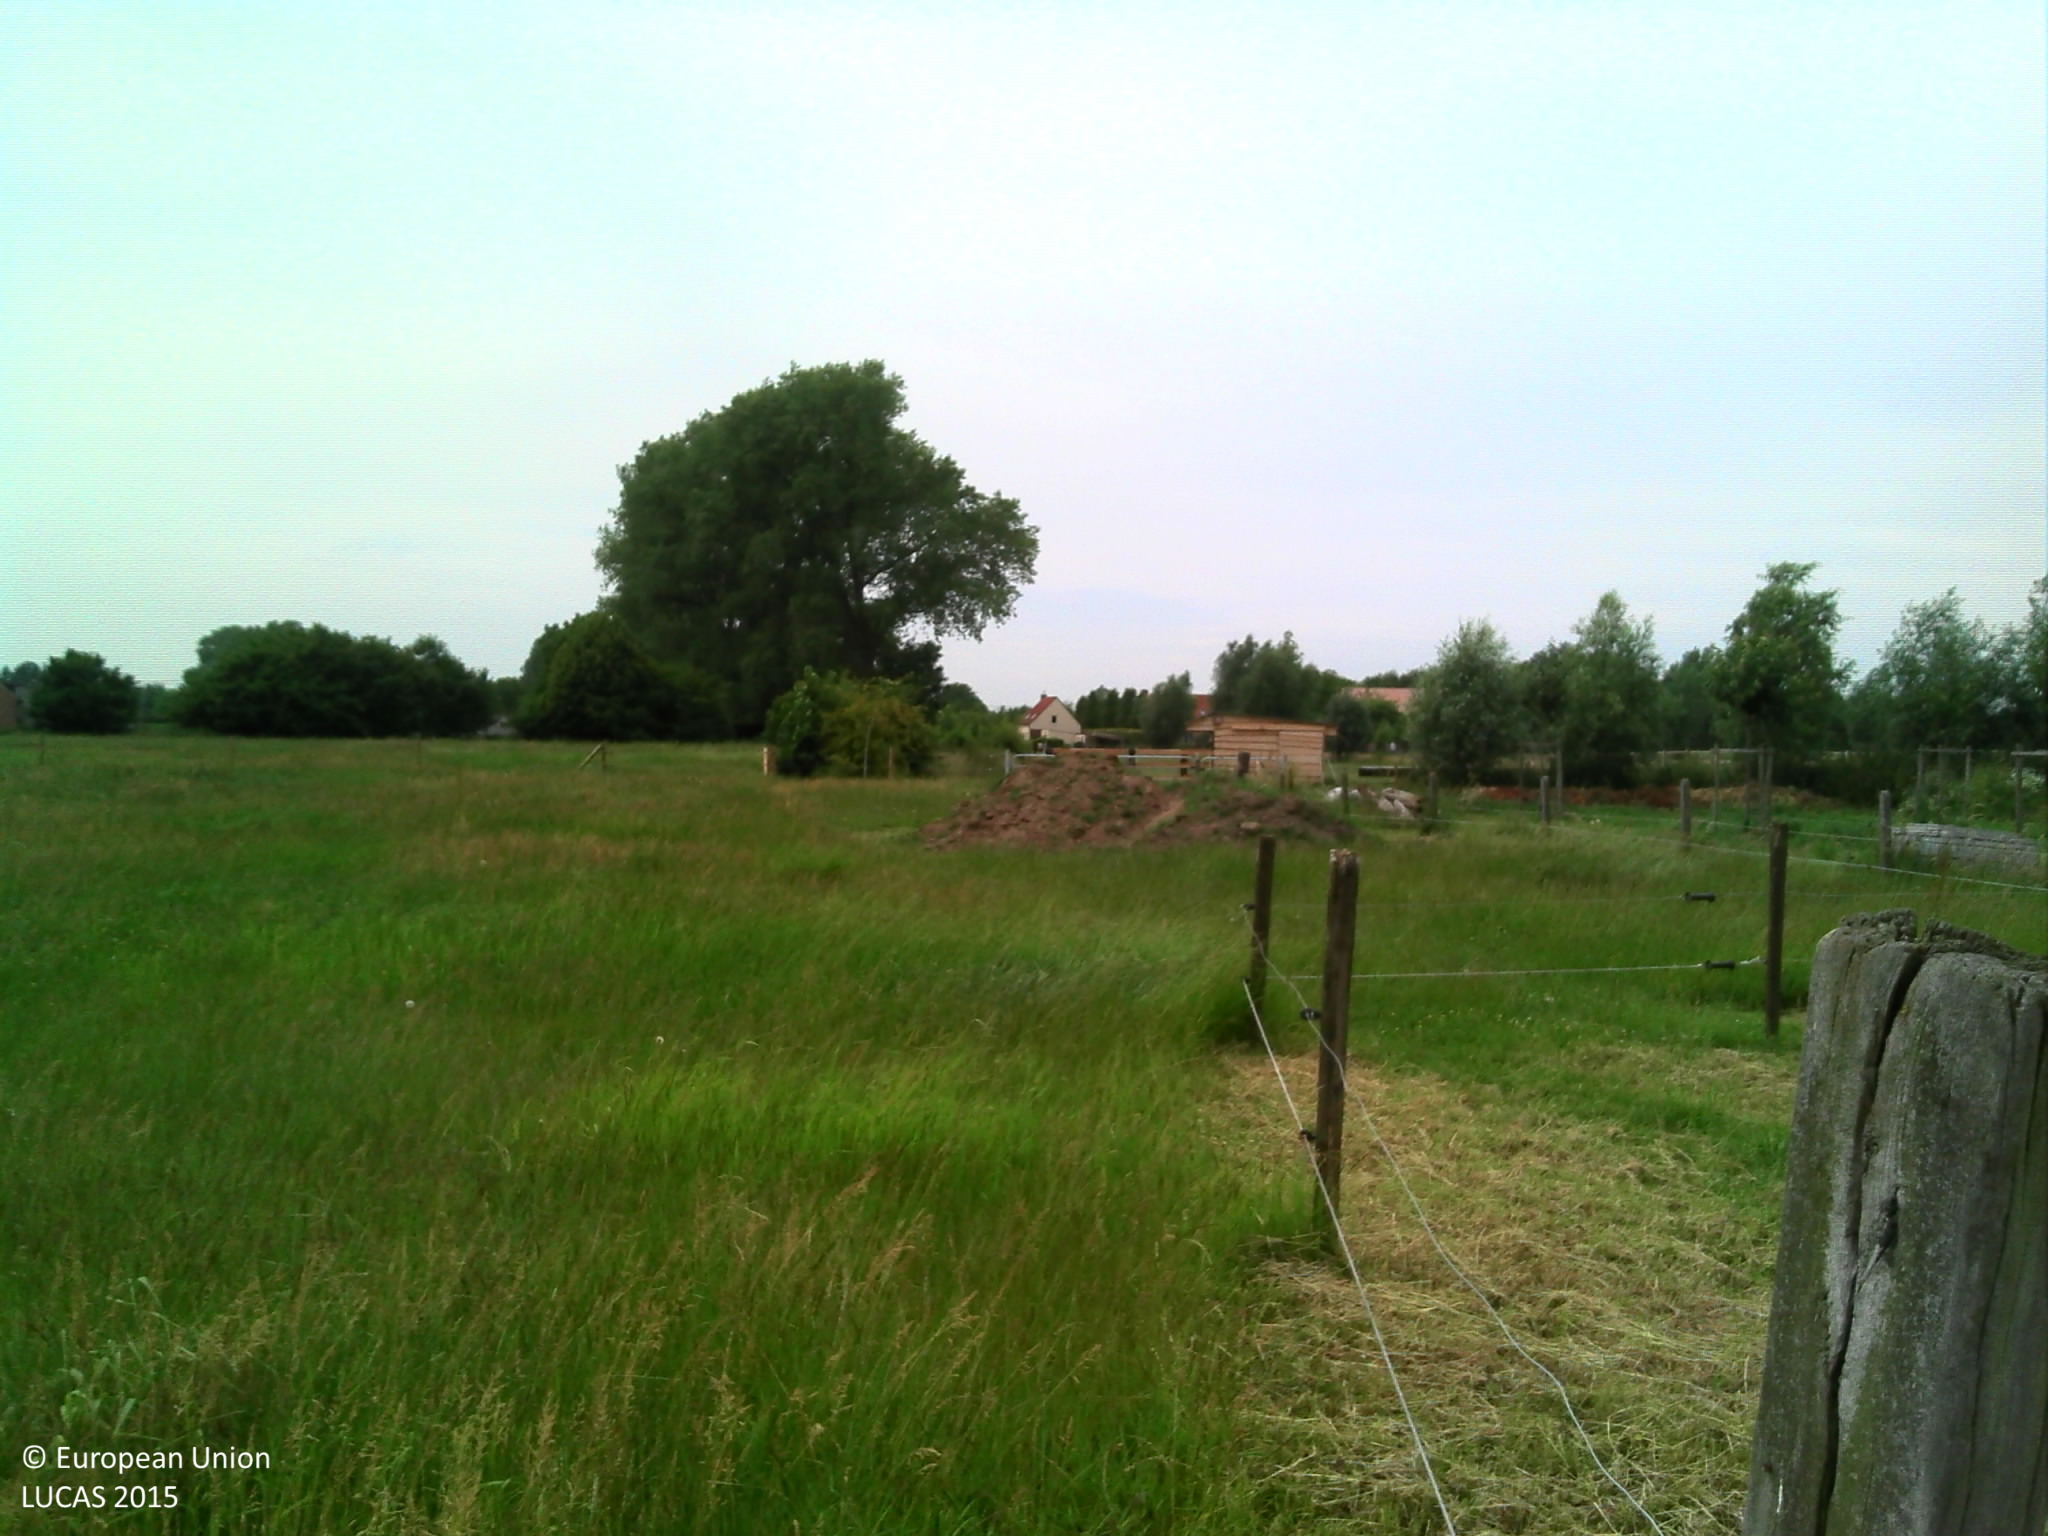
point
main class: Grassland
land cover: Grassland without tree/shrub cover
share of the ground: > 75 %
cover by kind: herbaceous plants 100 %
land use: Agriculture (excluding fallow land and kitchen gardens)
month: June
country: BE
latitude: 50.9509
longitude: 3.4297
